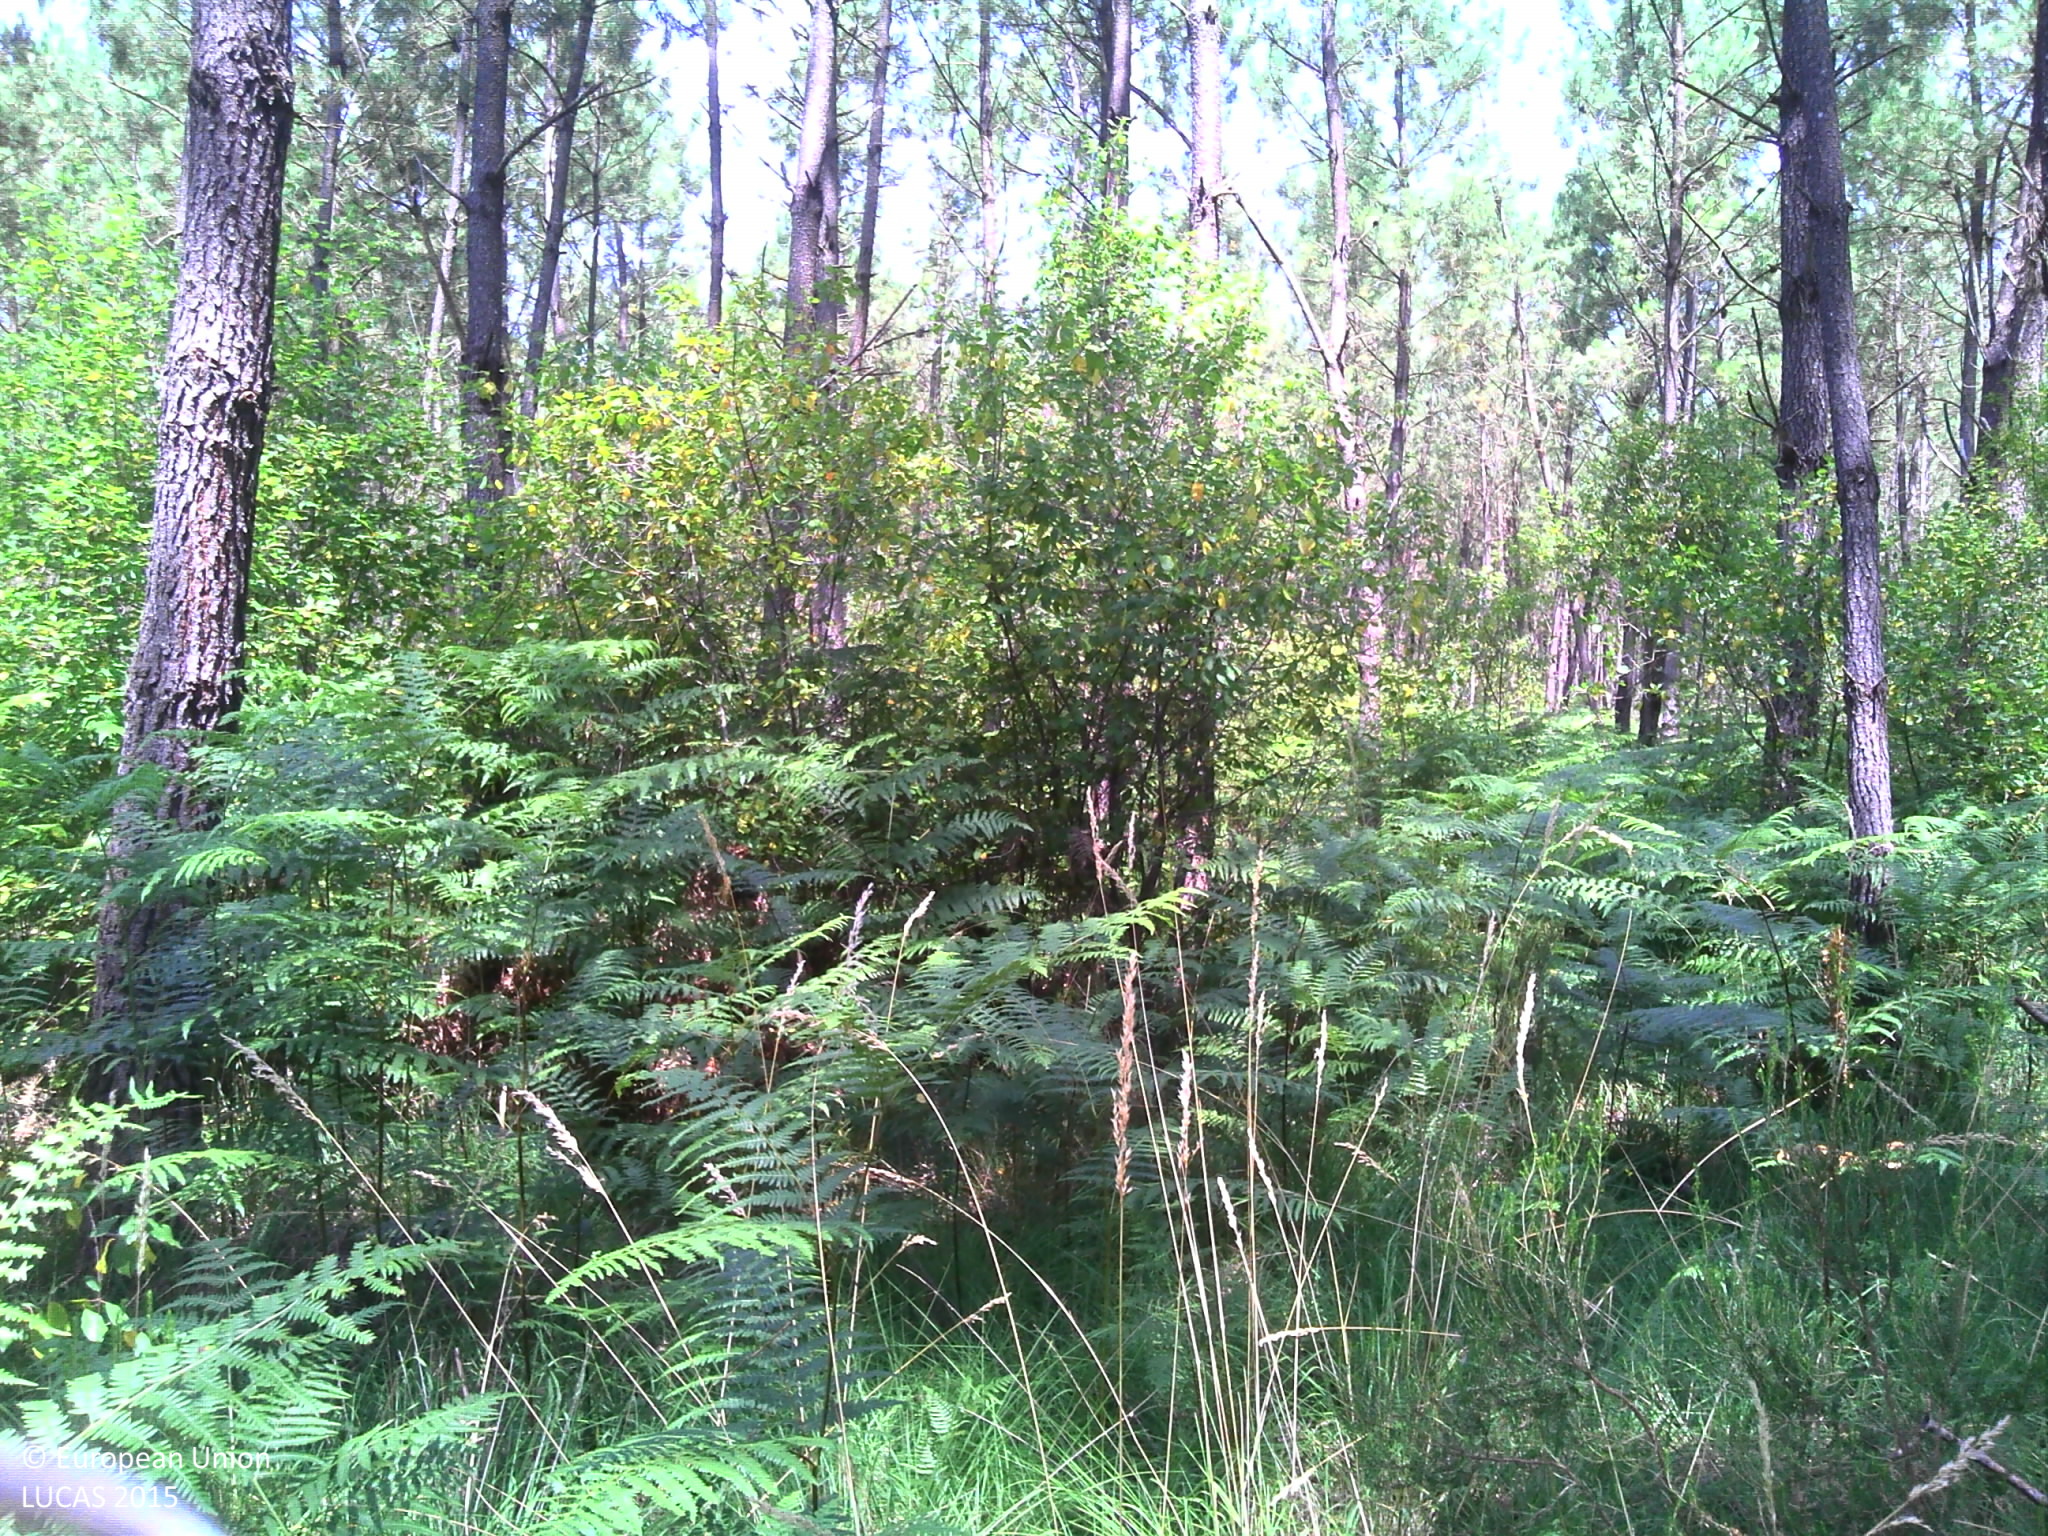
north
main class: Woodland
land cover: Pine dominated coniferous woodland
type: coniferous forest of the mediterranean region
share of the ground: > 75 %
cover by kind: coniferous forest trees 75 %, herbaceous plants 20 %, shrubs 5 %
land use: Forestry
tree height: > 5 m
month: July
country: FR
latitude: 44.2733
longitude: -0.6525
